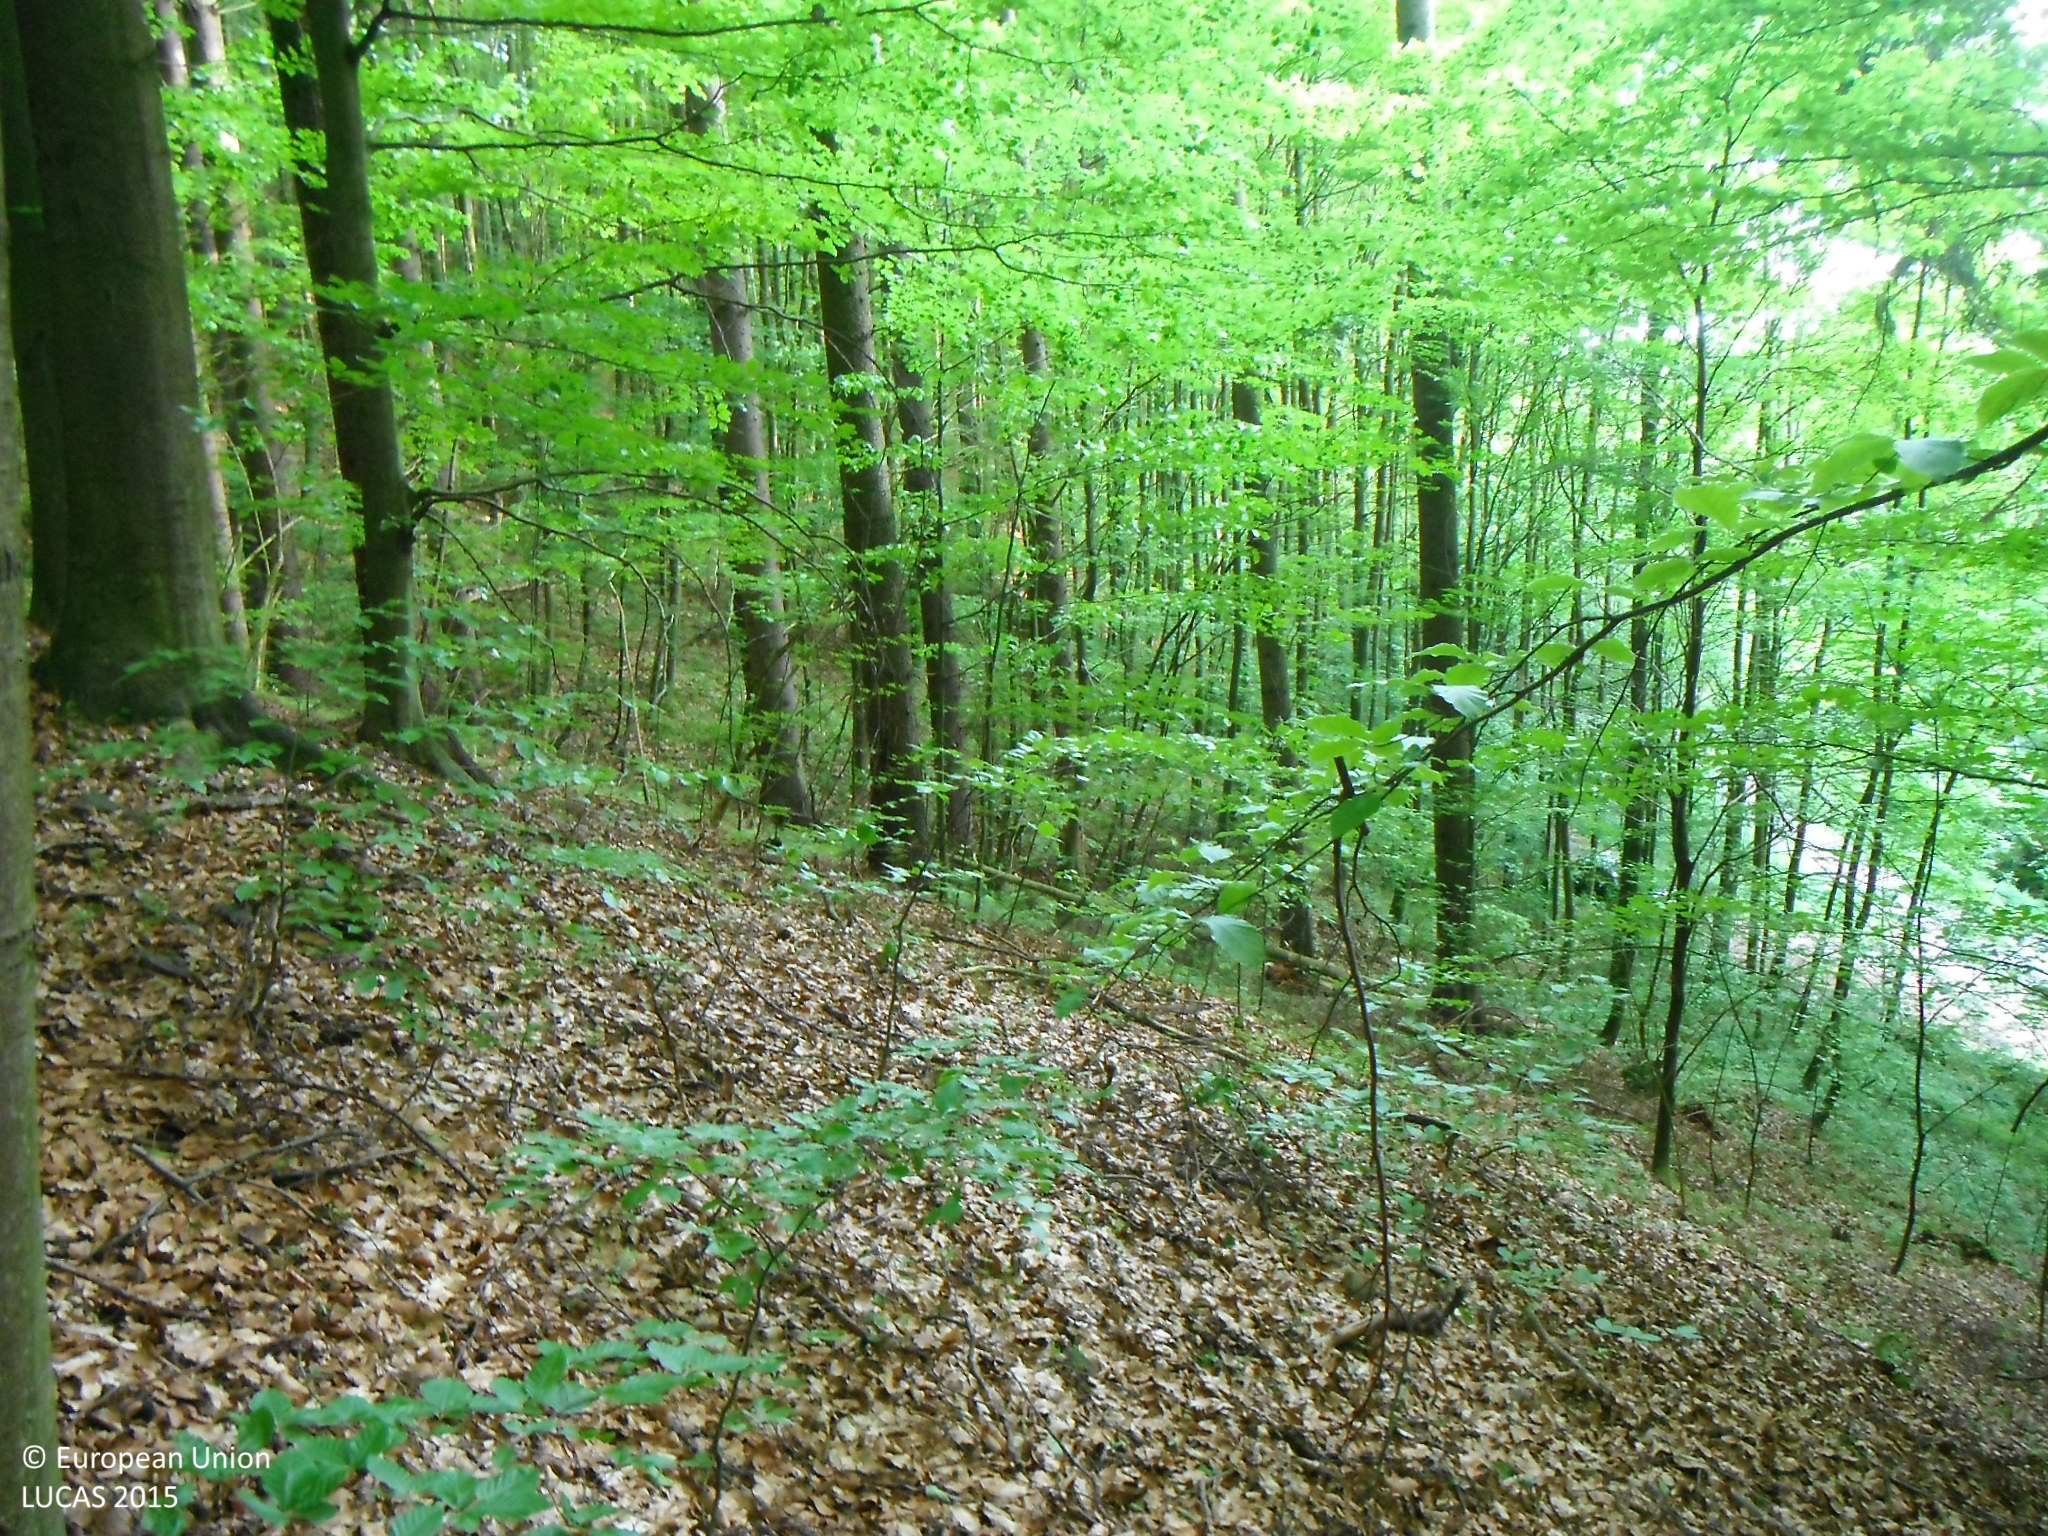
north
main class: Woodland
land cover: Broadleaved woodland
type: beech forest
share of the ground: > 75 %
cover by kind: broadleaved forest trees 100 %
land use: Forestry
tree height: > 5 m
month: June
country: SK
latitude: 48.4825
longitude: 19.2903
